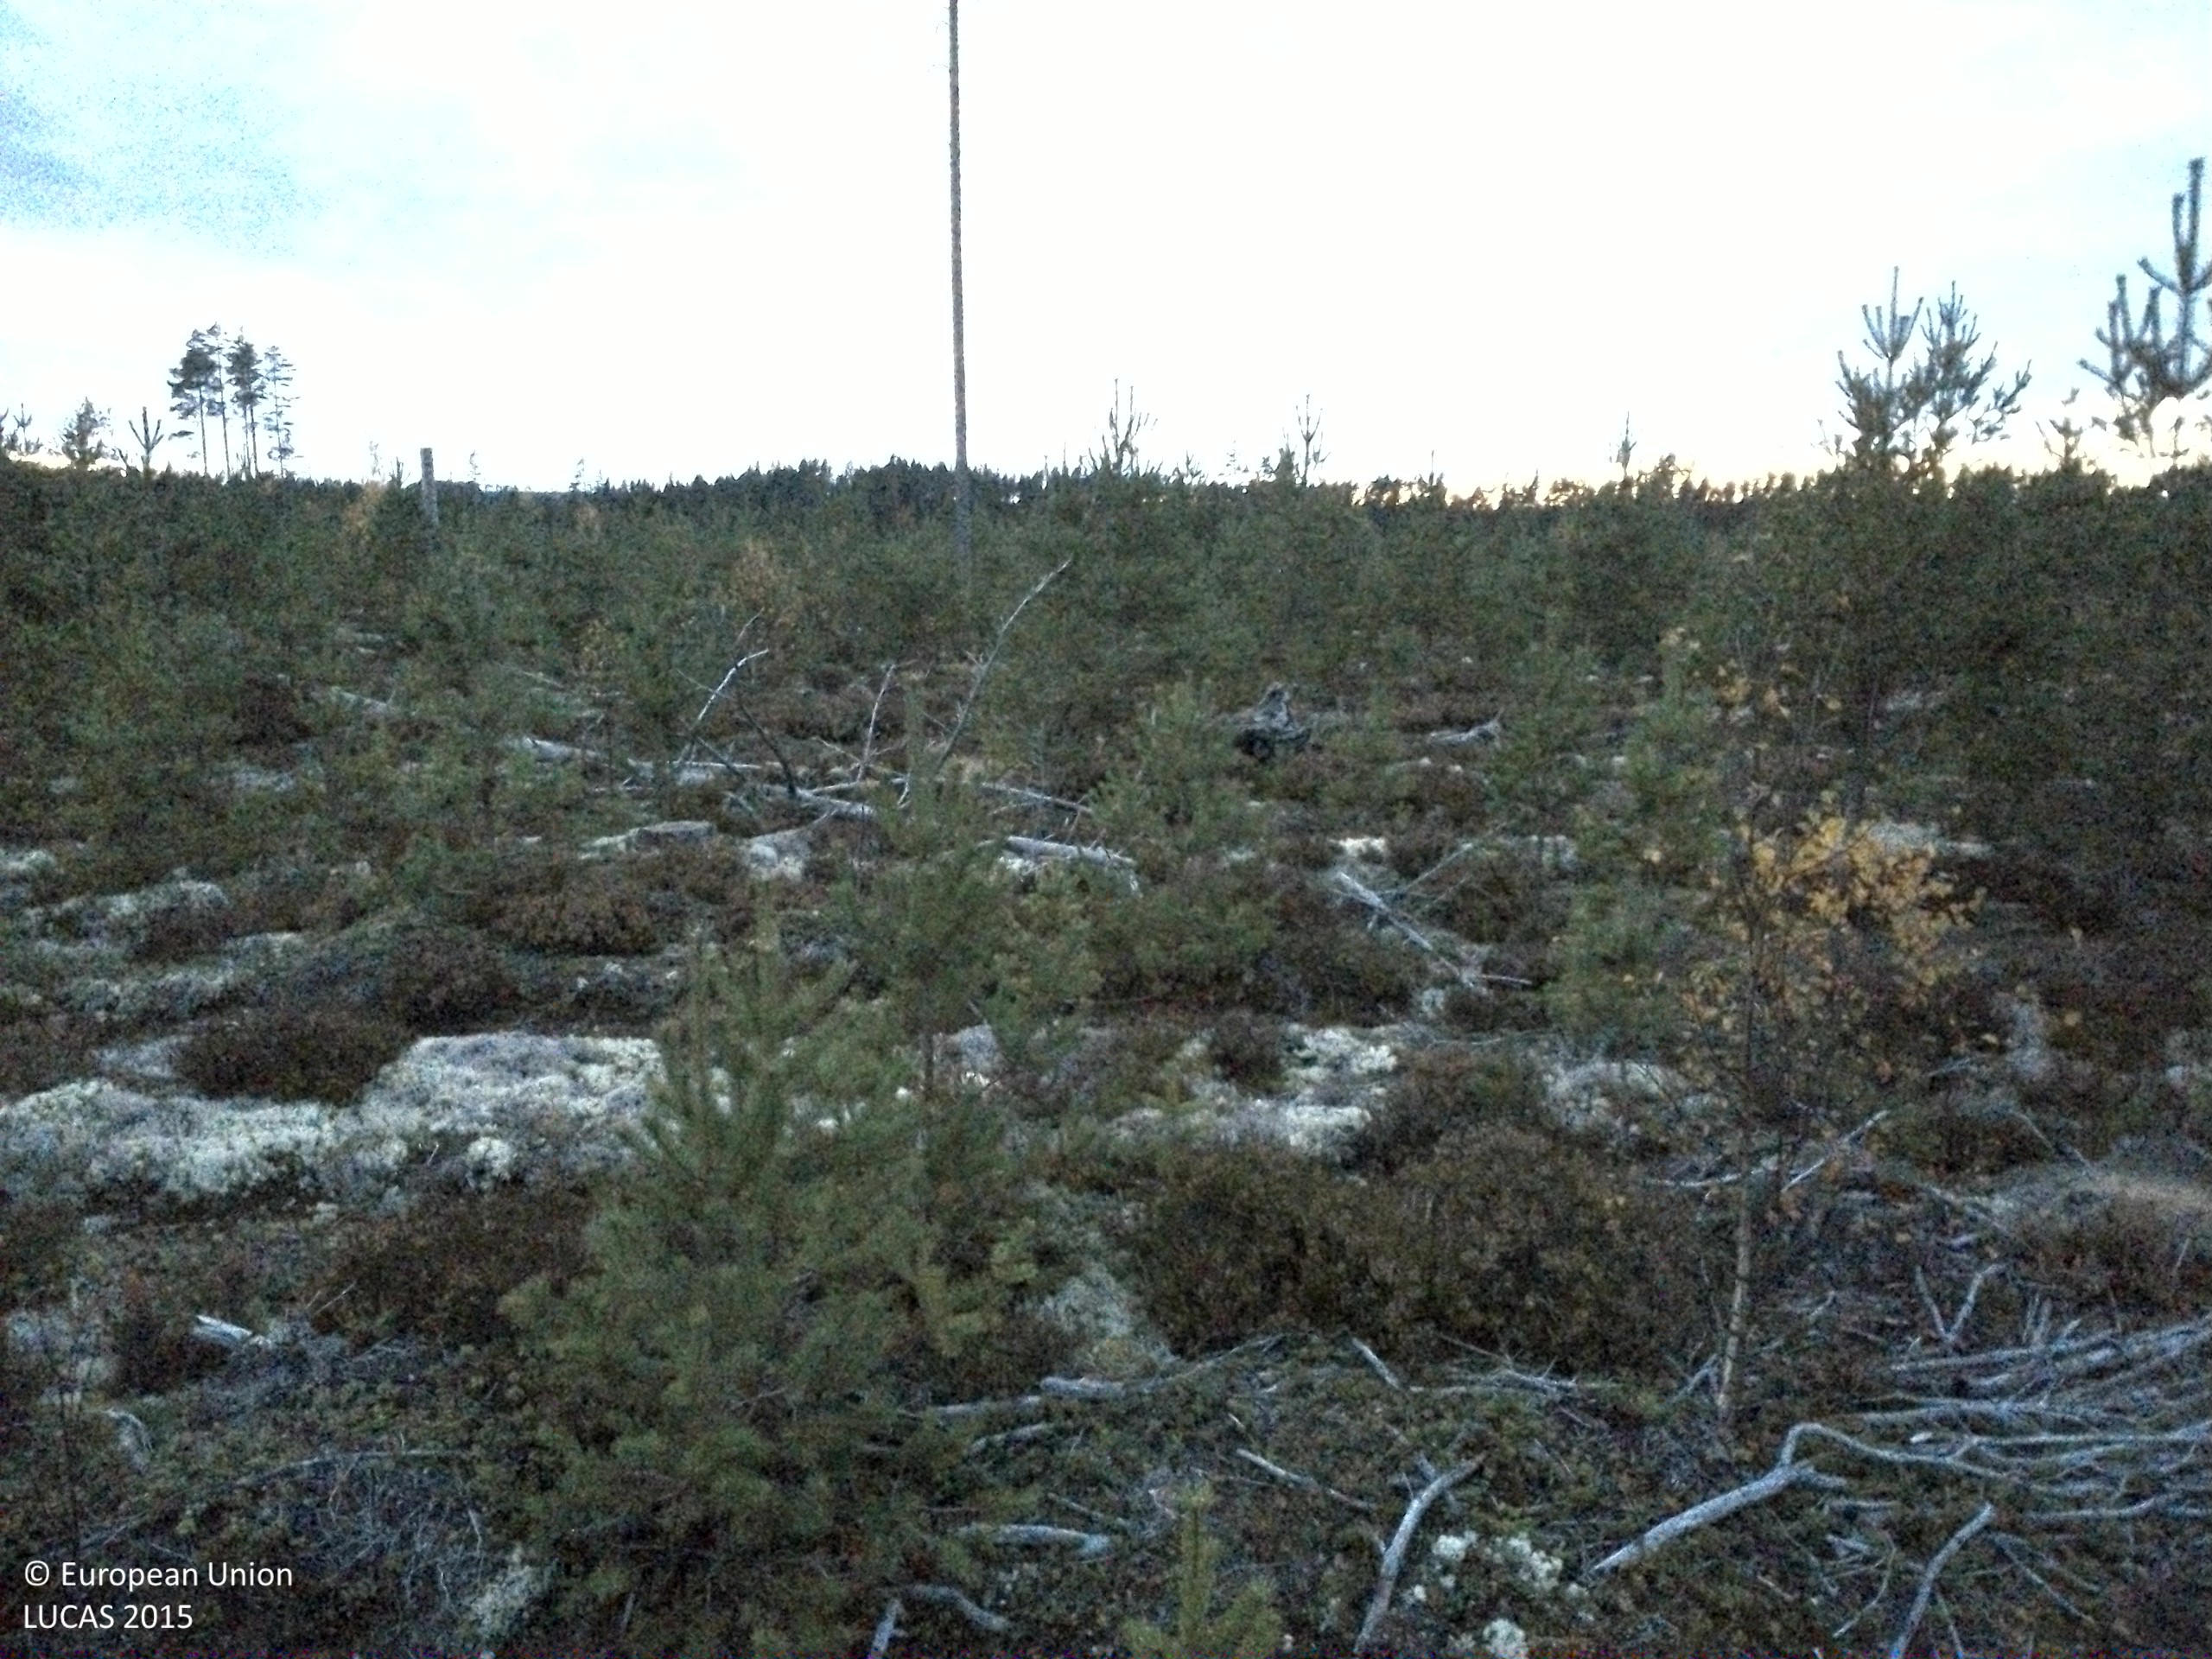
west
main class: Woodland
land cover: Pine dominated coniferous woodland
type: boreal forest
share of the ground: 25 - 50 %
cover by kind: shrubs 40 %, coniferous forest trees 35 %, lichens and mosses 10 %, consolidated bare surface 10 %, broadleaved forest trees 5 %
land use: Forestry
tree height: < 5 m
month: October
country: SE
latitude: 61.3343
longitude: 15.0866
